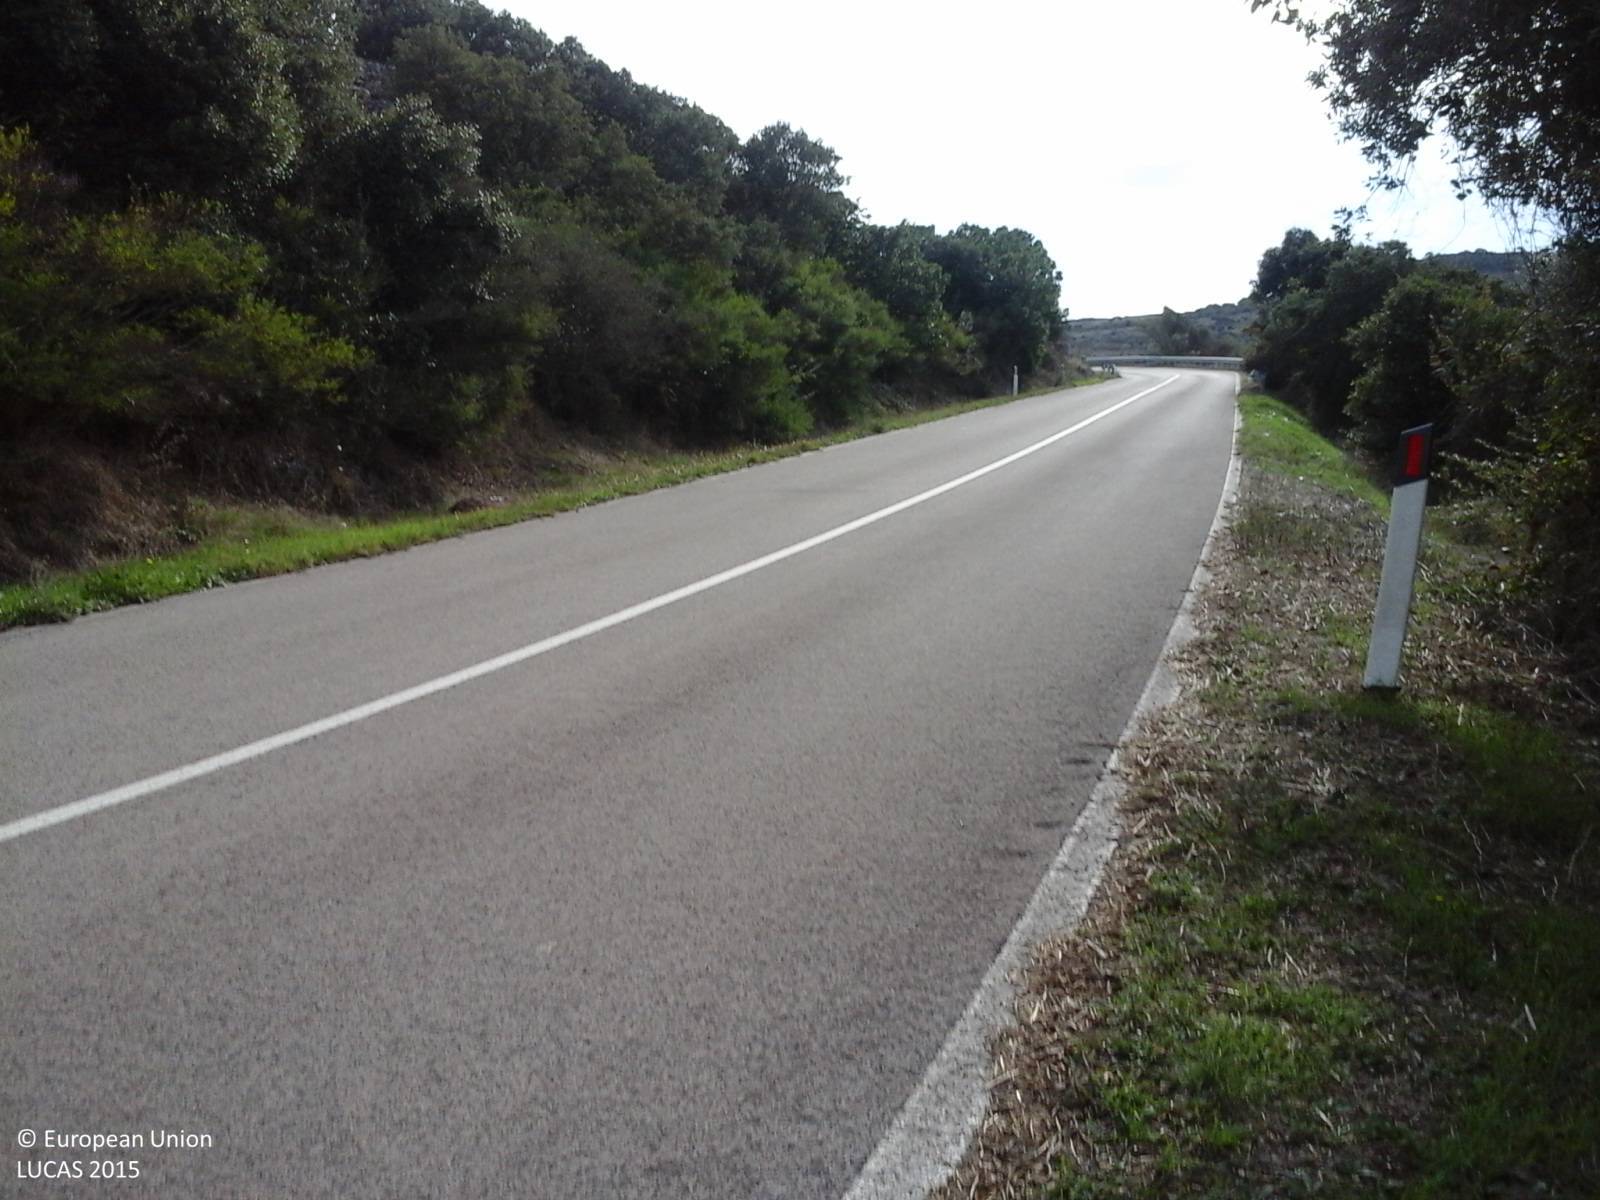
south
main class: Shrubland
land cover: Shrubland with sparse tree cover
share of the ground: > 75 %
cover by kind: shrubs 95 %, broadleaved forest trees 5 %
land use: Semi-natural and natural areas not in use
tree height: < 5 m
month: October
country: IT
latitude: 40.3643
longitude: 8.4886
